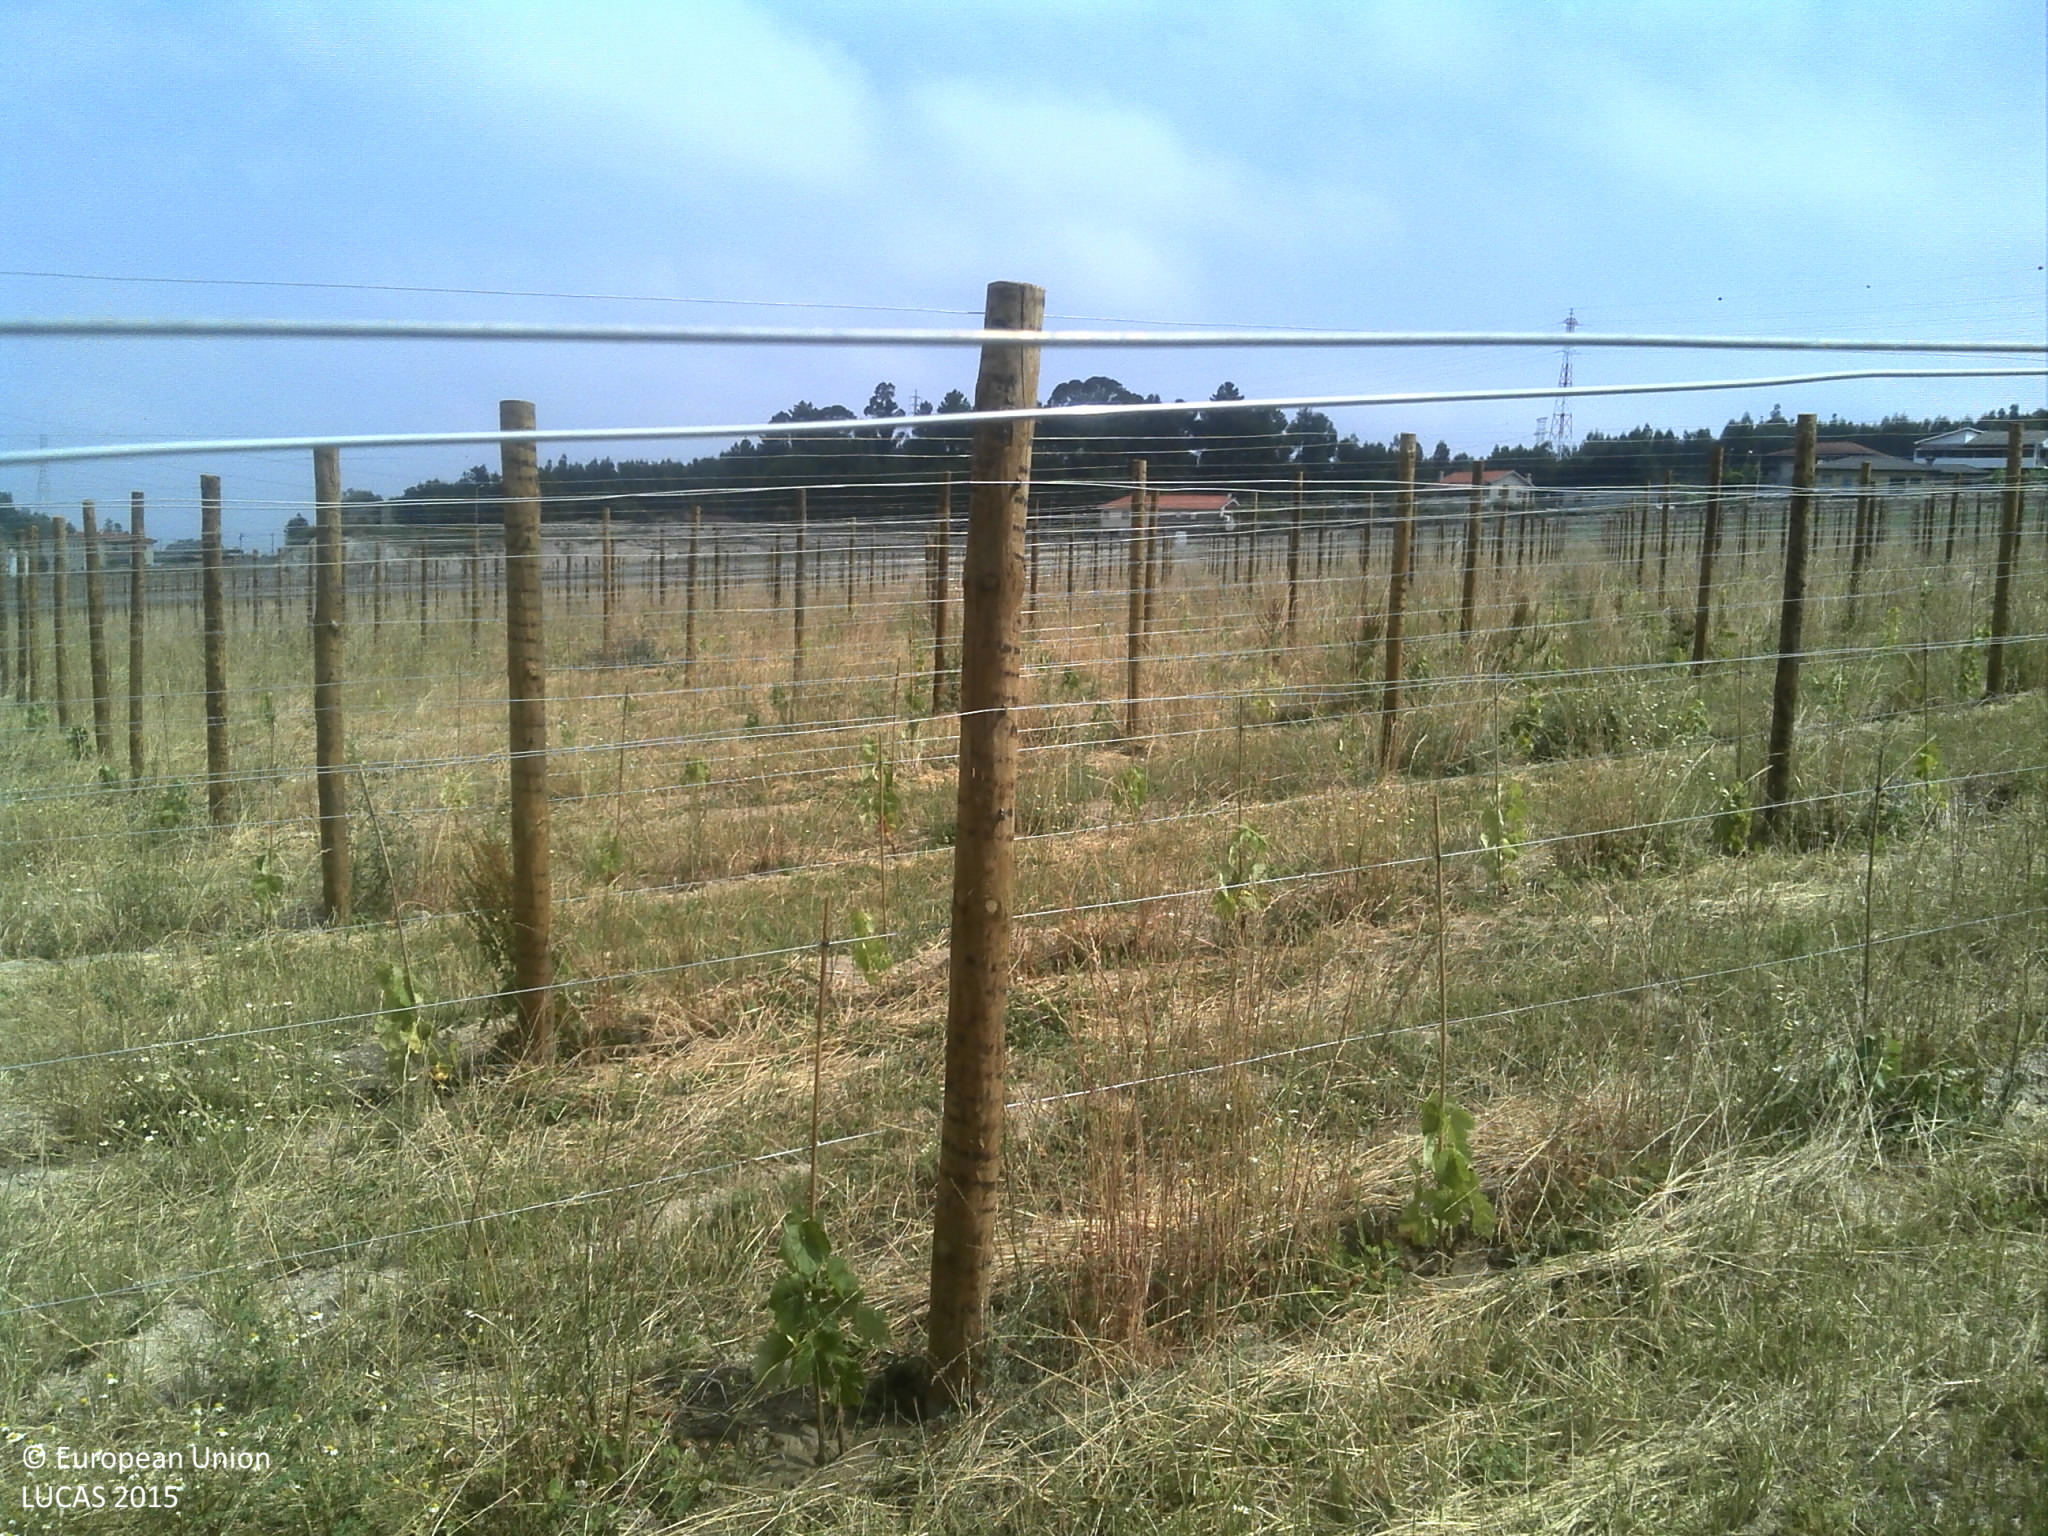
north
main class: Cropland
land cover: Vineyards
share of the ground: < 10 %
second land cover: Grassland without tree/shrub cover
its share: 50 - 75 %
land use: Agriculture (excluding fallow land and kitchen gardens)
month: June
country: PT
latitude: 41.1470
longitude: -8.1425
